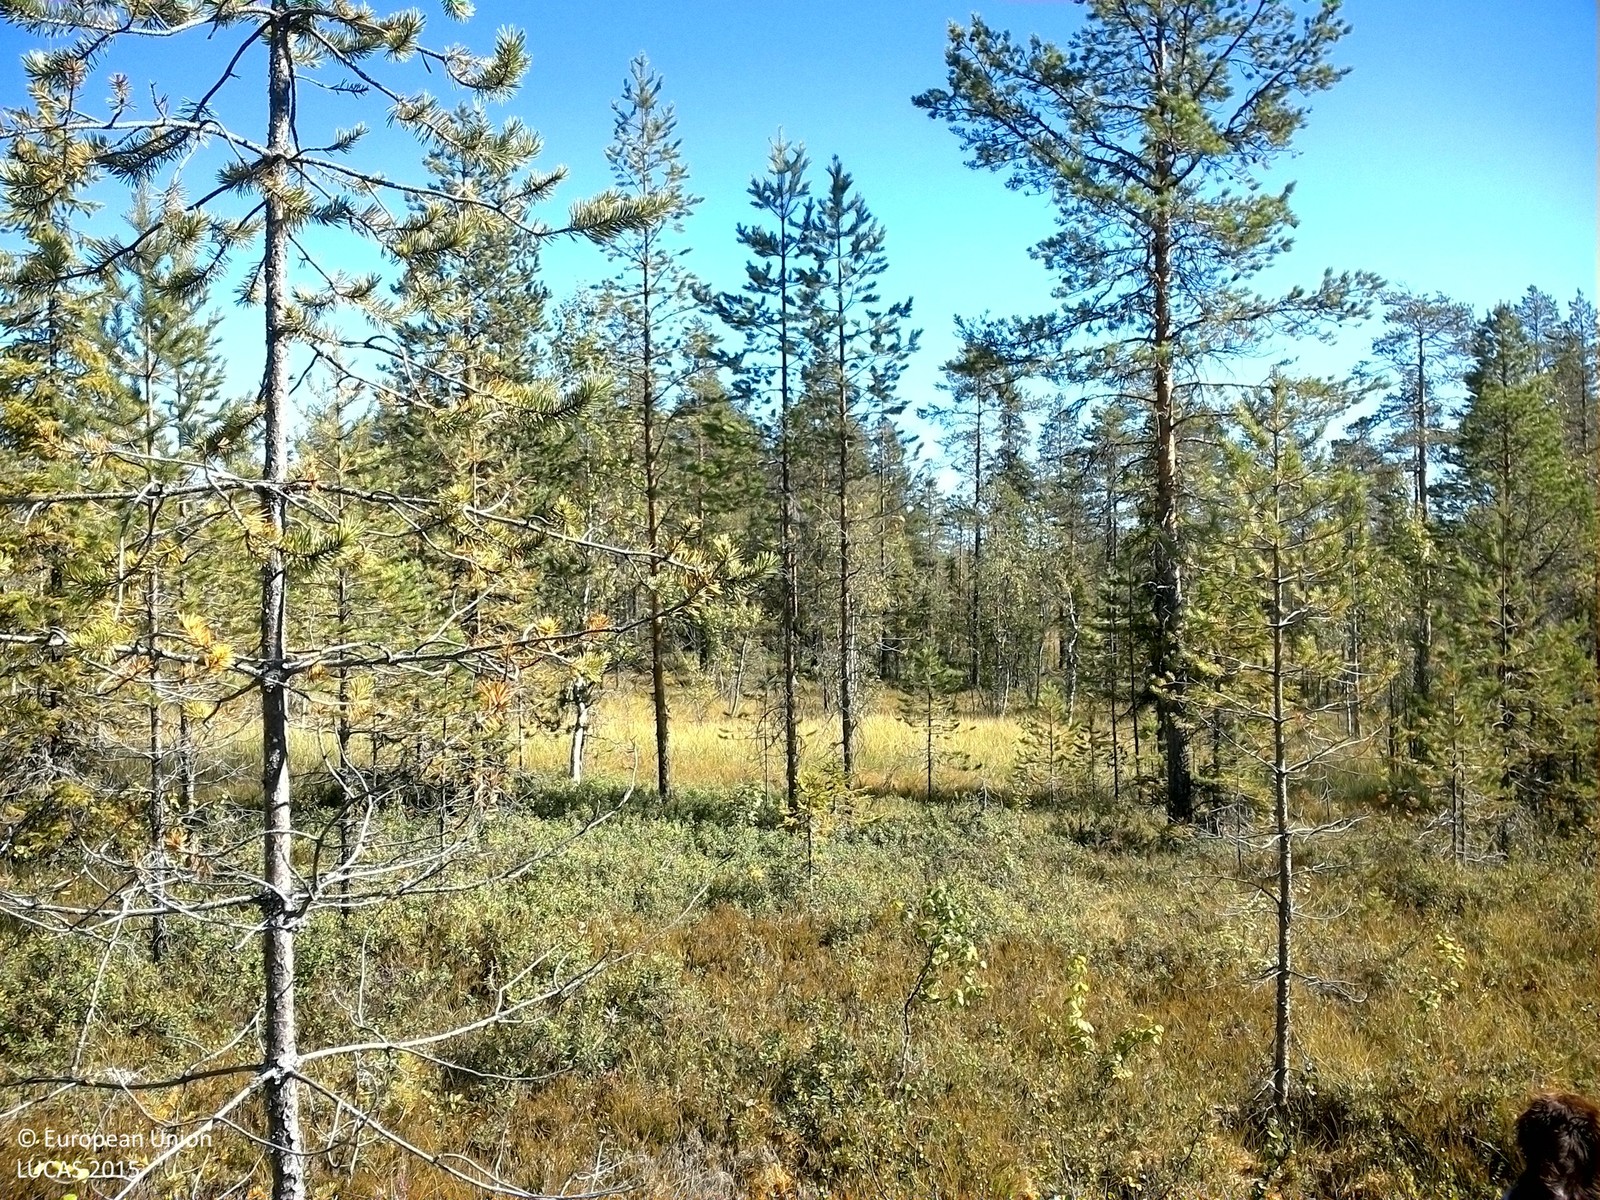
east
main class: Woodland
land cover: Pine dominated coniferous woodland
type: boreal forest
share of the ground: 10 - 25 %
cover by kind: shrubs 50 %, coniferous forest trees 20 %, lichens and mosses 15 %, herbaceous plants 10 %, broadleaved forest trees 5 %
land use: Semi-natural and natural areas not in use
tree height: < 5 m
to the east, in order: Pine dominated coniferous woodland; Inland marshes; Pine dominated coniferous woodland; Other coniferous woodland
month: August
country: SE
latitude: 63.7317
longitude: 17.8509
